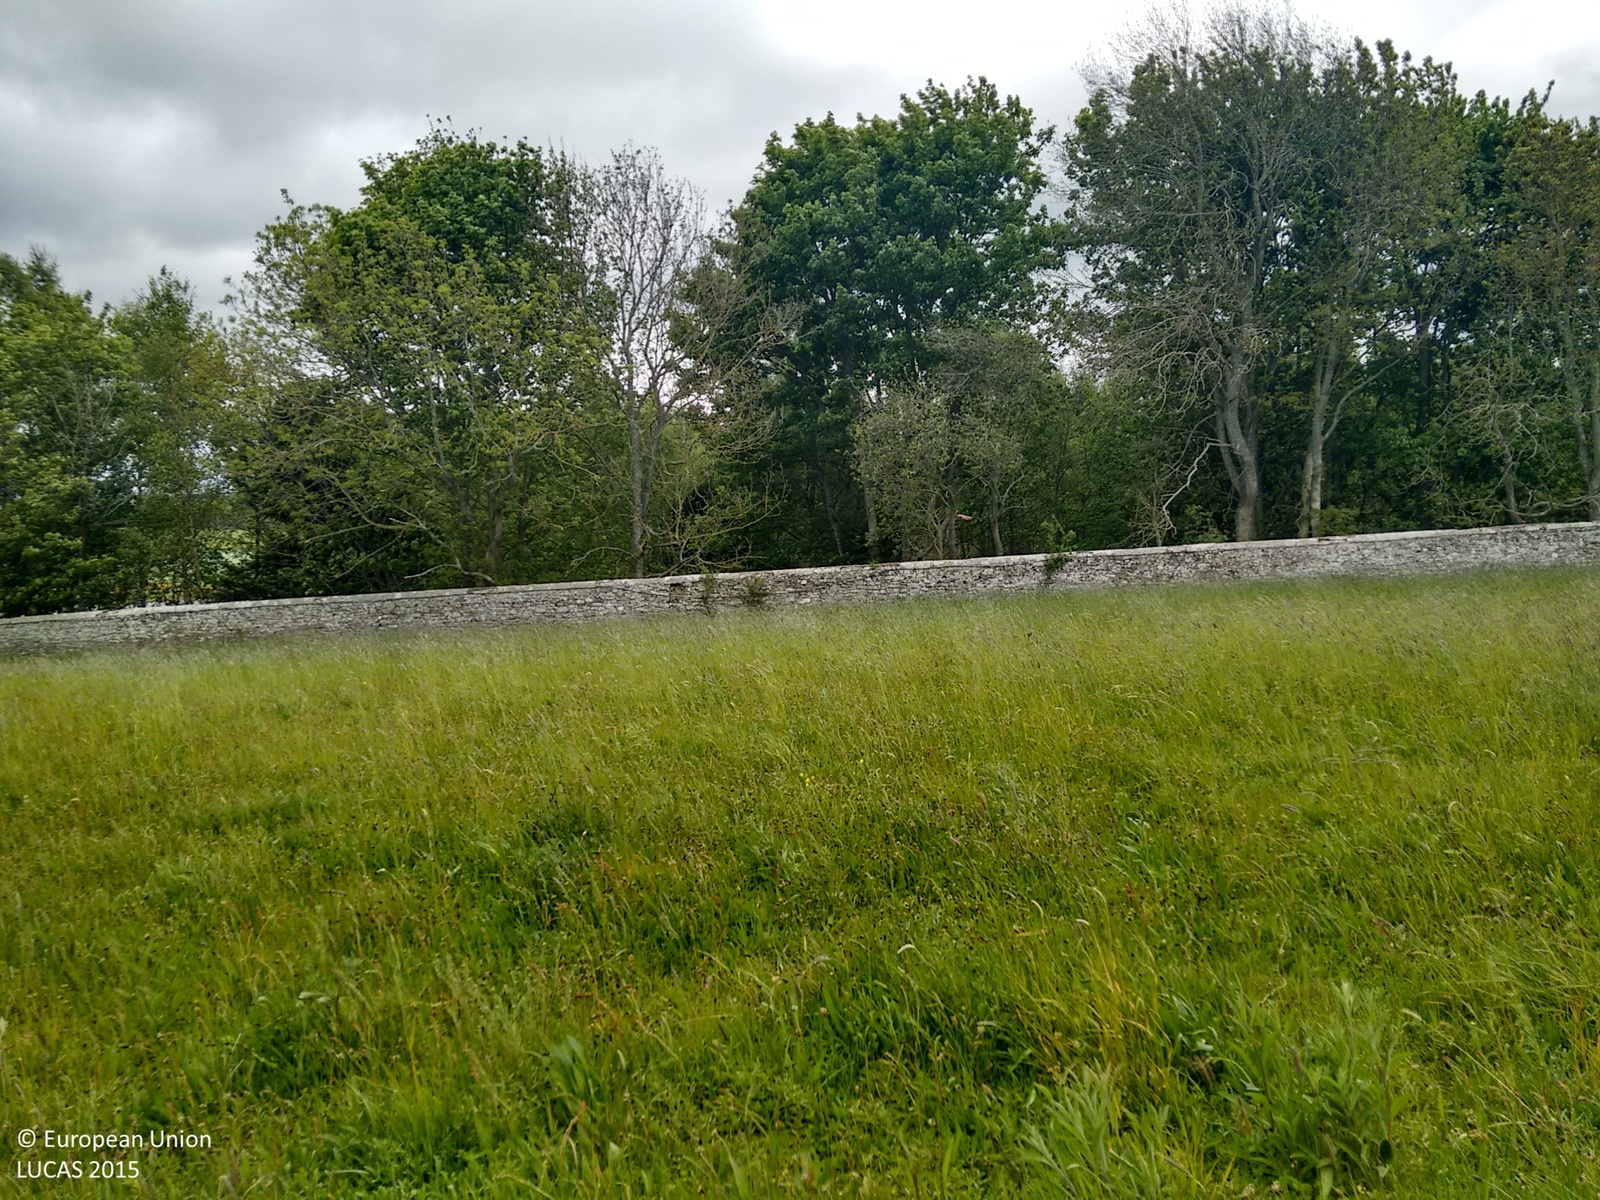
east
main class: Grassland
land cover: Grassland without tree/shrub cover
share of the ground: > 75 %
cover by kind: herbaceous plants 100 %
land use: Agriculture (excluding fallow land and kitchen gardens)
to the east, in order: Grassland without tree/shrub cover; Dry stone walls; Other mixed woodland; Electric lines; Other mixed woodland; Artificial constructions in urban areas; Grass margins; Managed hedges; Fences; Grassland without tree/shrub cover
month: May
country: GB
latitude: 55.6201
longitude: -2.3970
